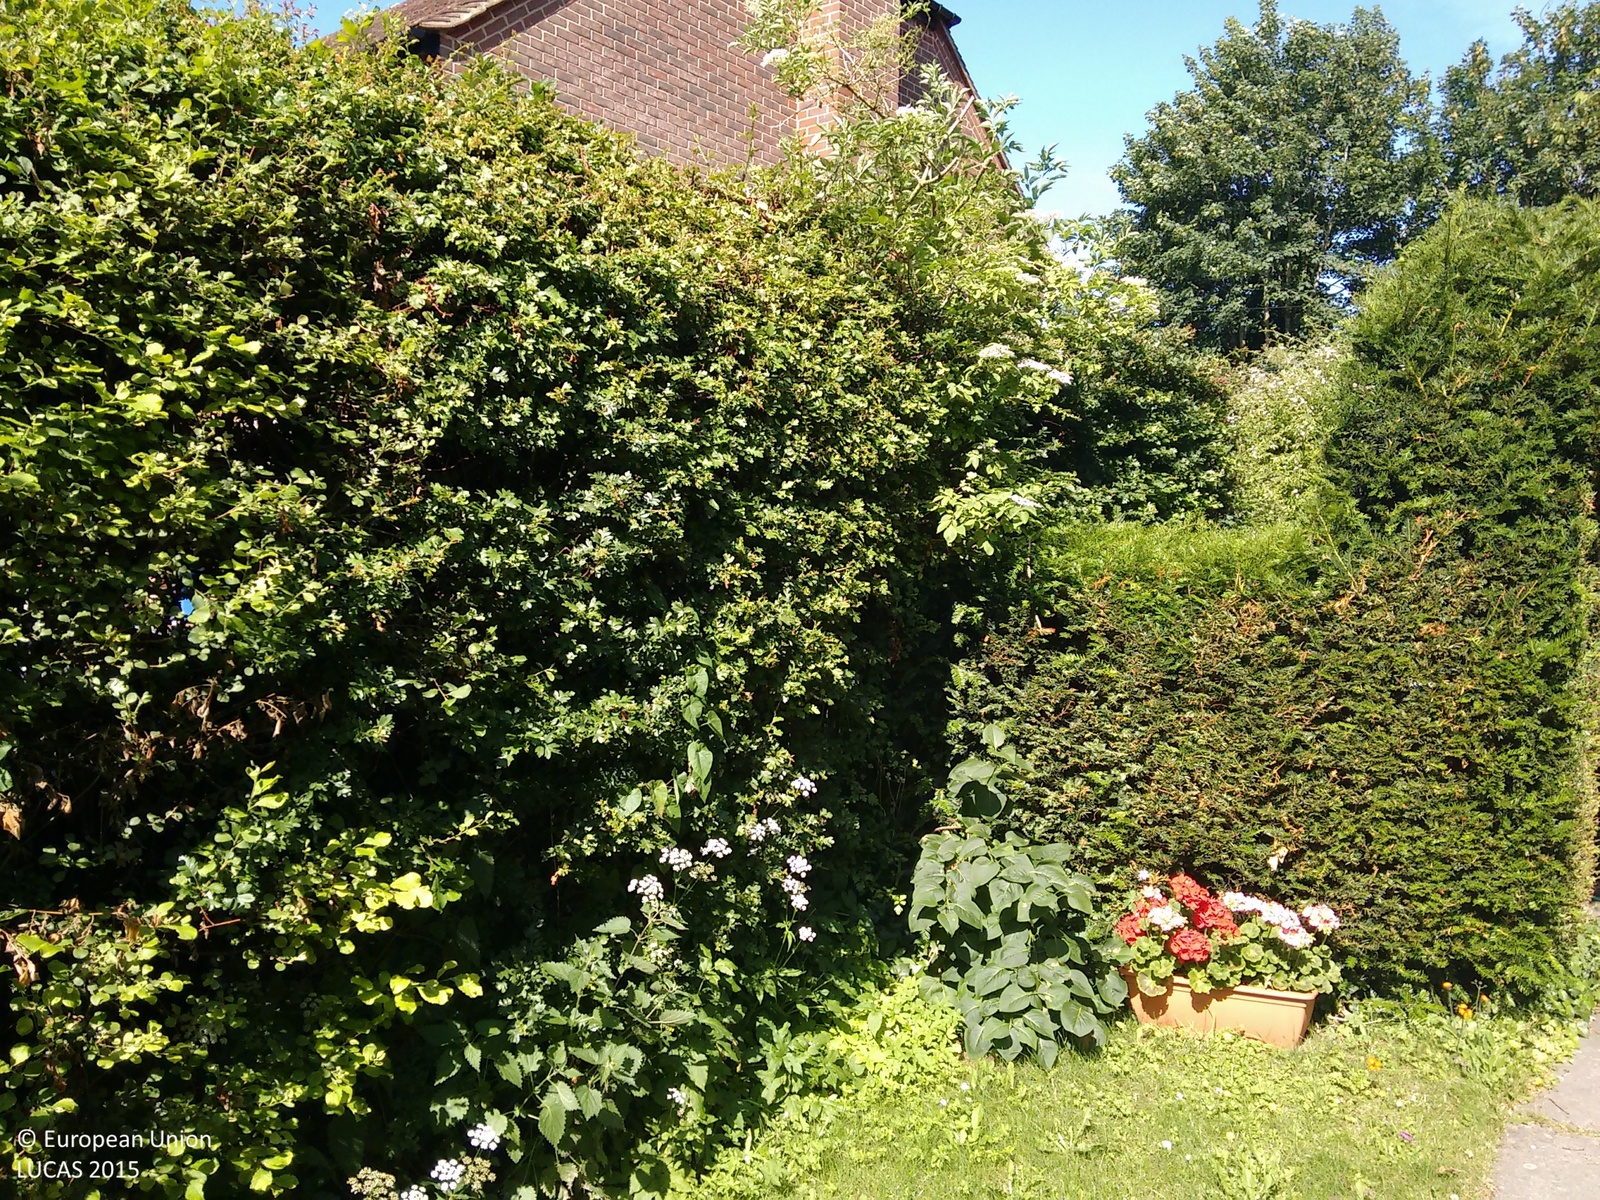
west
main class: Grassland
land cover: Grassland without tree/shrub cover
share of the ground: > 75 %
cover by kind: herbaceous plants 100 %
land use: Residential
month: July
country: GB
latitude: 50.9055
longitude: -0.7782
